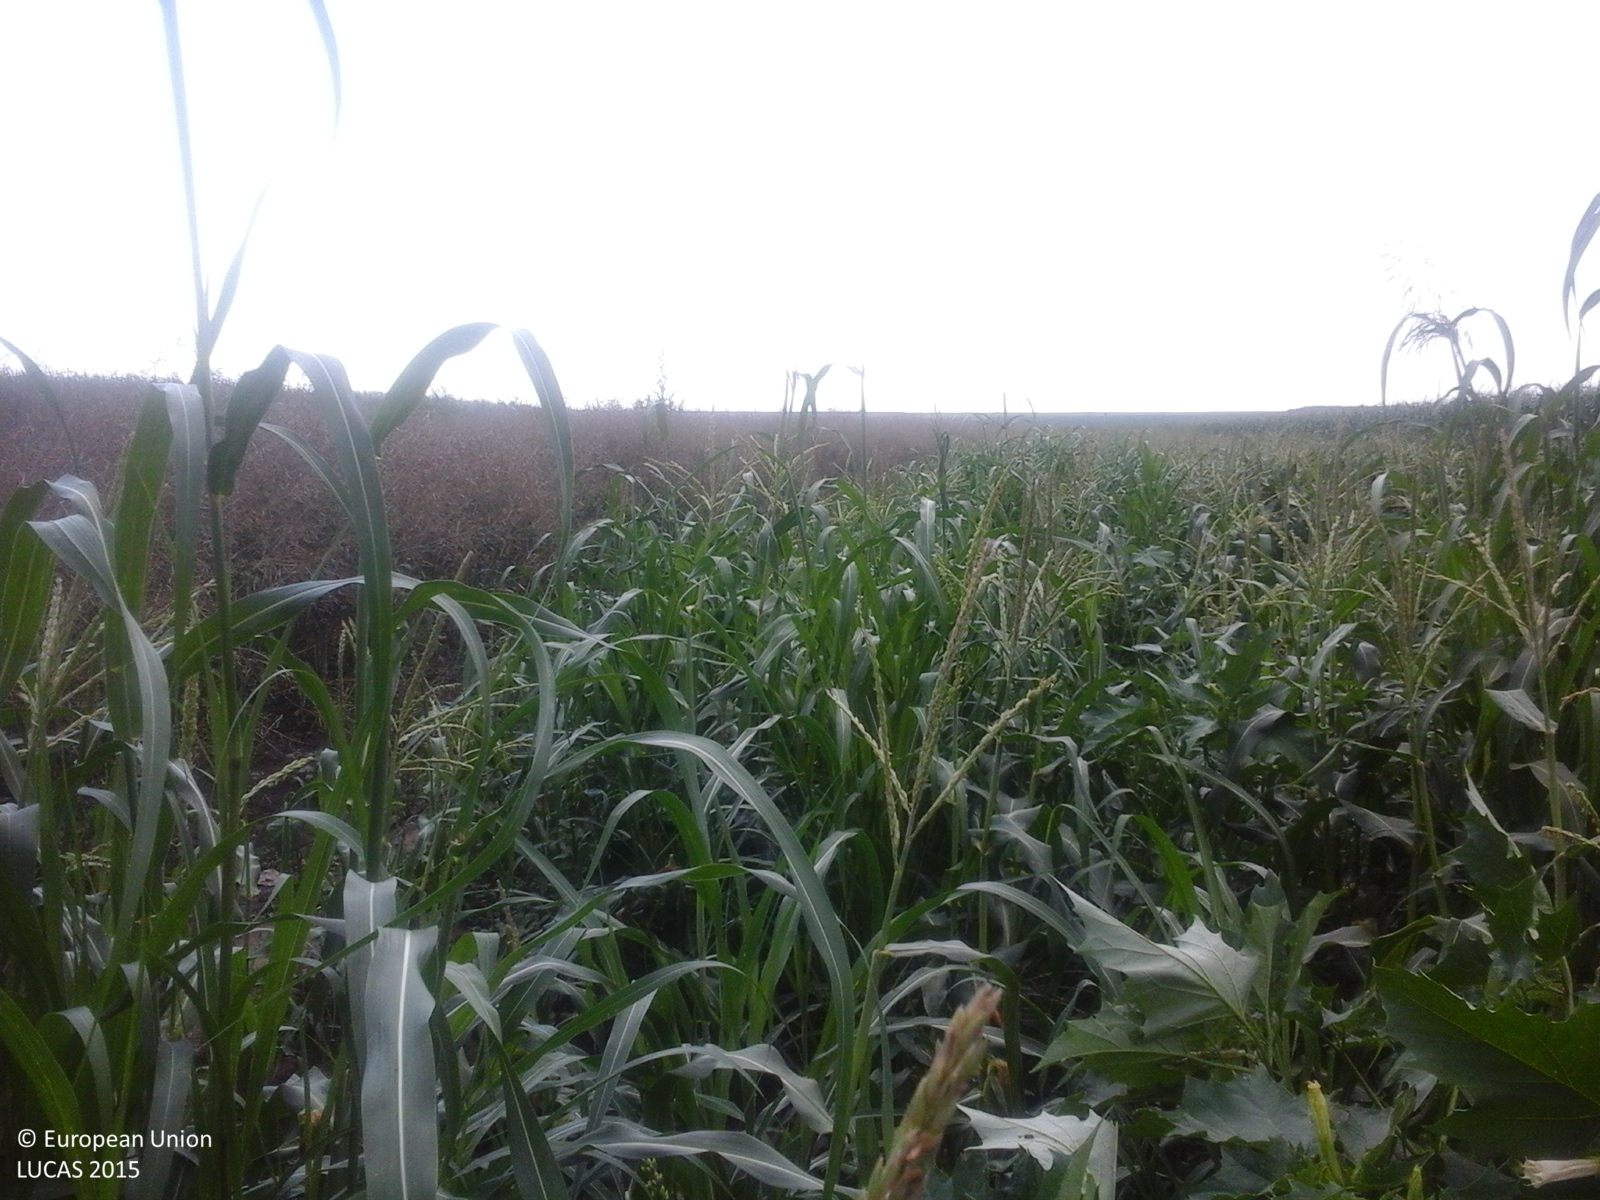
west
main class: Cropland
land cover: Maize
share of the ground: 50 - 75 %
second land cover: Other fresh vegetables
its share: 25 - 50 %
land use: Agriculture (excluding fallow land and kitchen gardens)
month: July
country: RO
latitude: 43.7345
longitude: 25.6948
